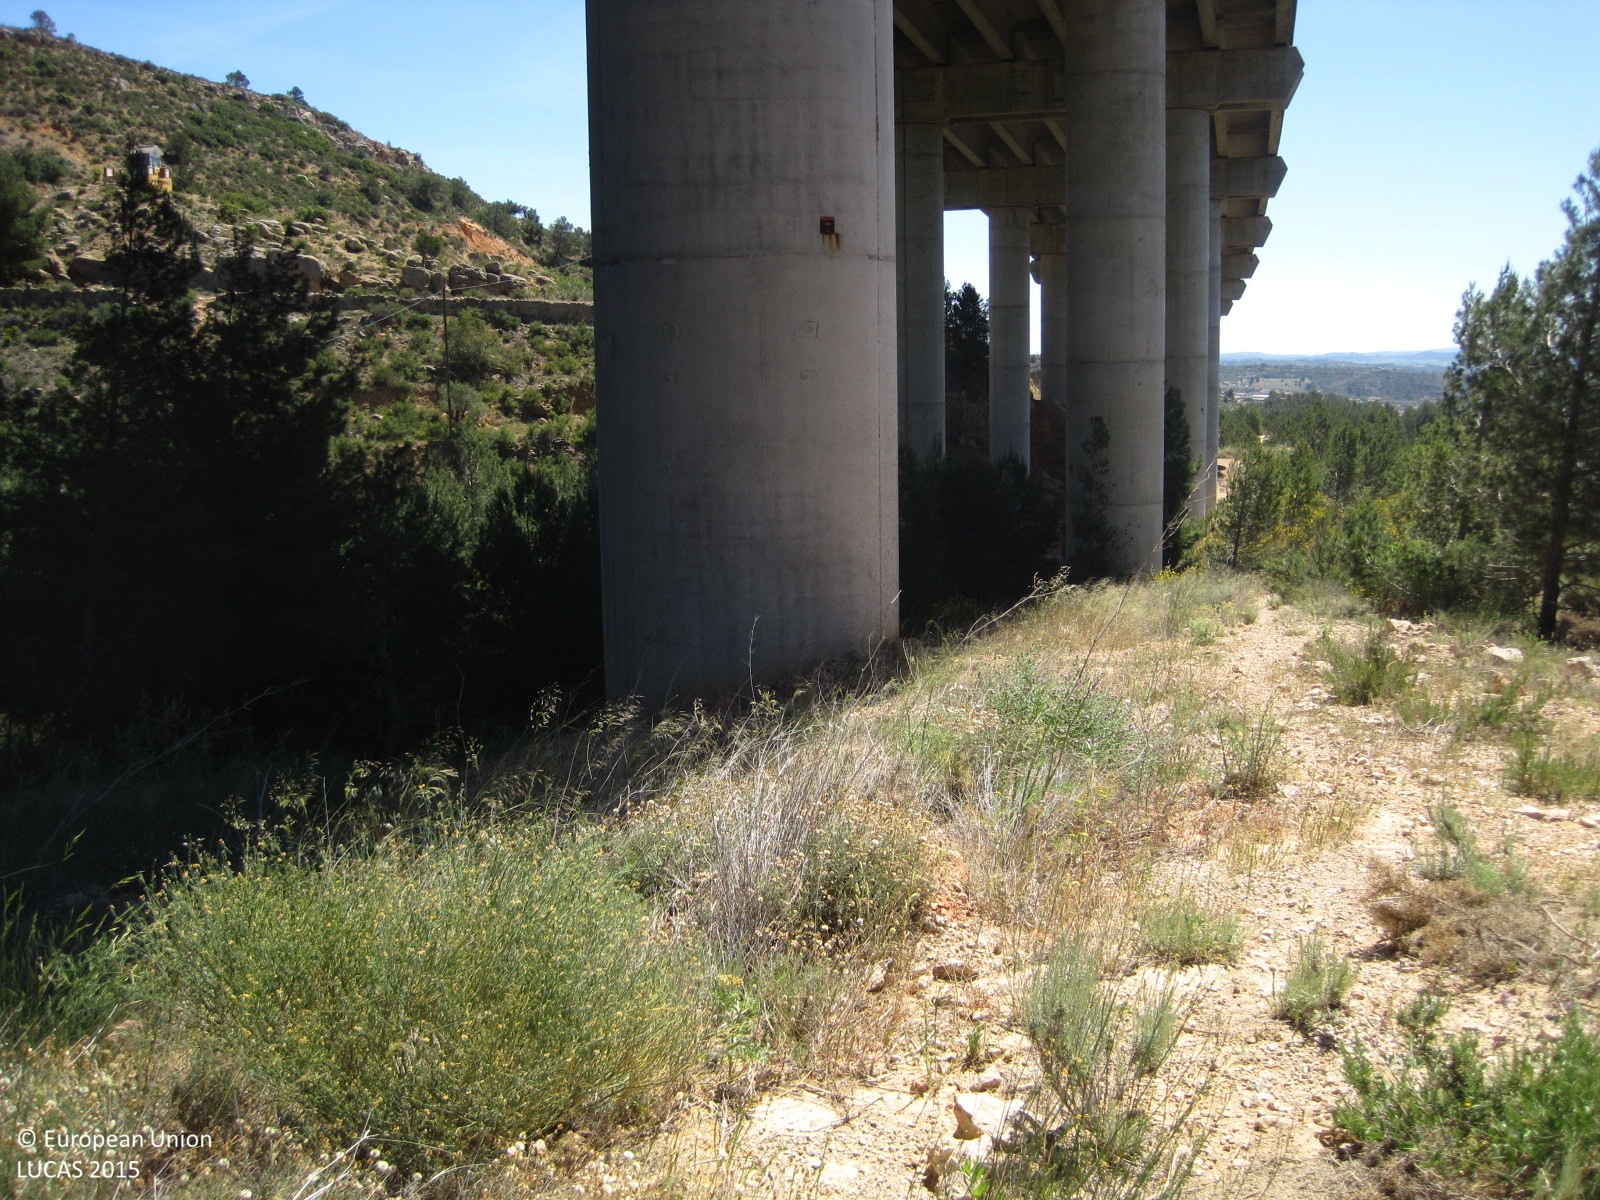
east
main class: Artificial land
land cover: Non built-up linear features
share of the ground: > 75 %
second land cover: Grassland without tree/shrub cover
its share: > 75 %
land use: Road transport
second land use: Forestry
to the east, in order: Paved roads, cycling and walking lanes; Grassland without tree/shrub cover; Pine dominated coniferous woodland; Shrubland with sparse tree cover; Tracks; Shrubland with sparse tree cover; Dry stone walls; Paved roads, cycling and walking lanes; Electric lines; Paved roads, cycling and walking lanes; Dry stone walls; Shrubland with sparse tree cover
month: May
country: ES
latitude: 39.4305
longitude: -0.8148
